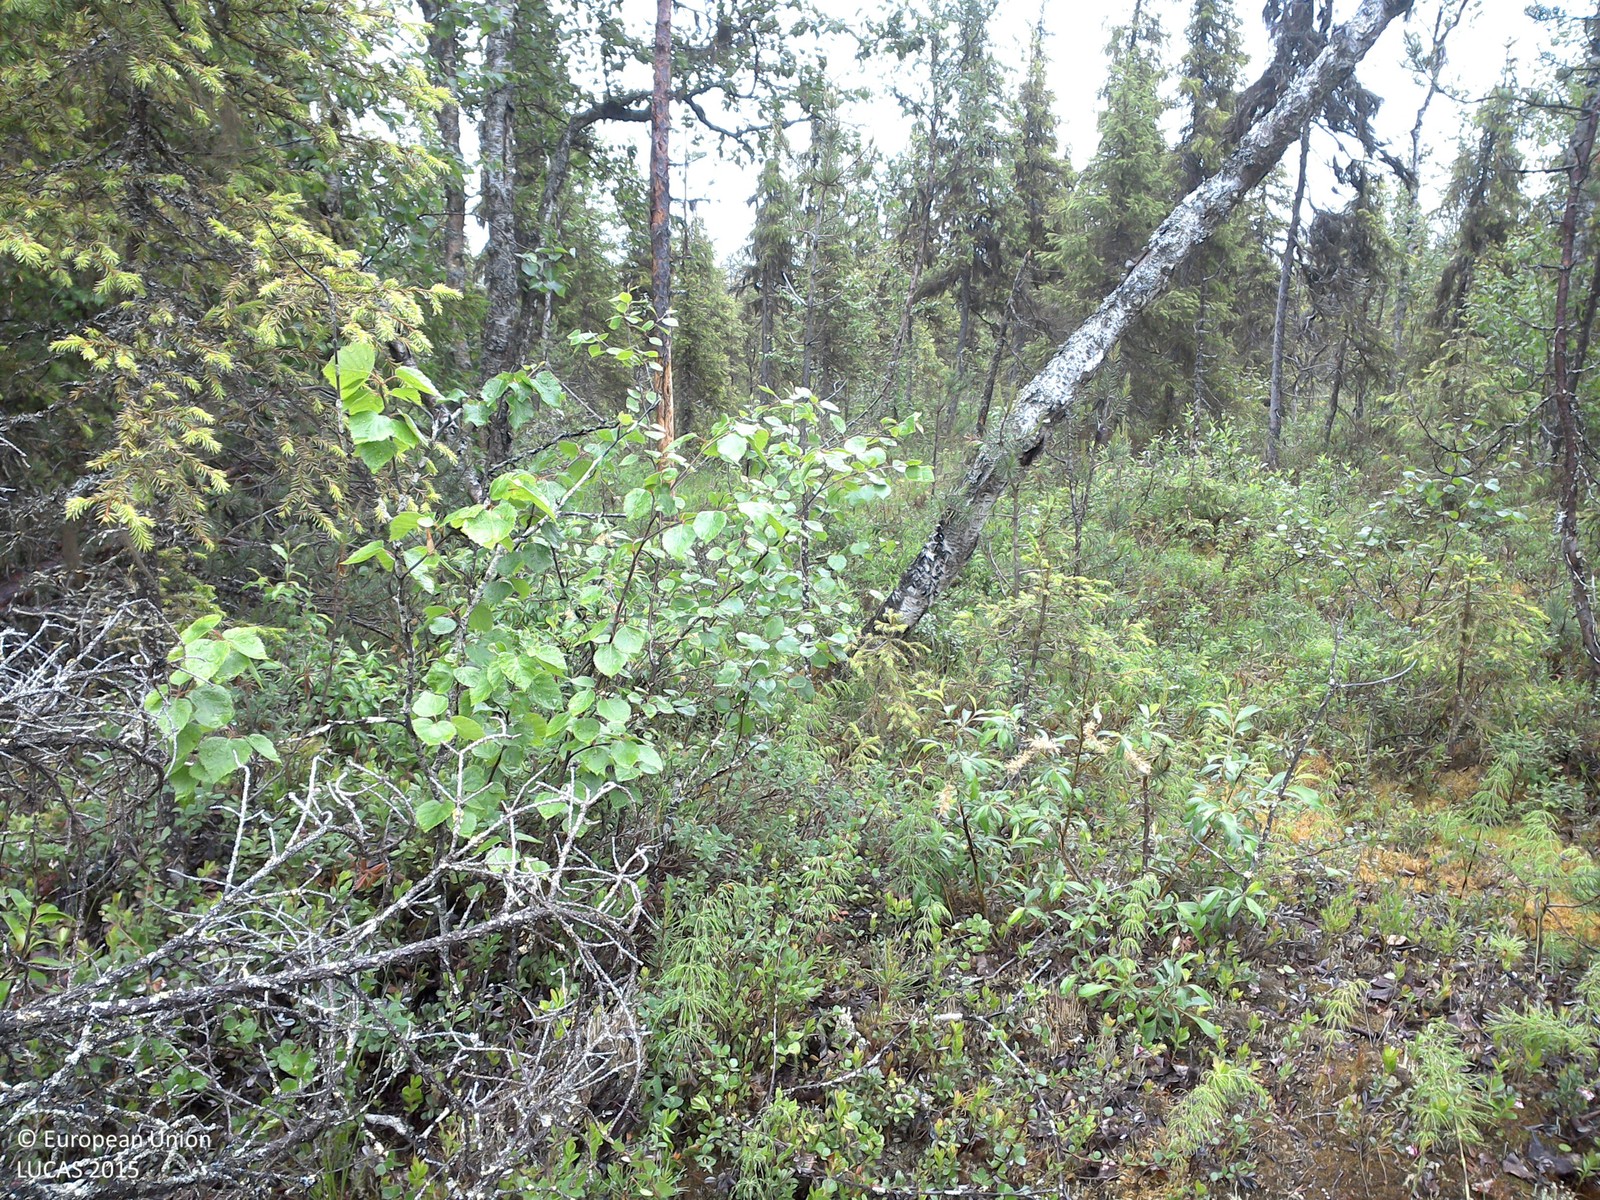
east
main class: Woodland
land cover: Pine dominated mixed woodland
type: boreal forest
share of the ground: 25 - 50 %
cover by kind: shrubs 55 %, coniferous forest trees 20 %, broadleaved forest trees 10 %, herbaceous plants 10 %, lichens and mosses 5 %
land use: Forestry
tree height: > 5 m
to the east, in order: Pine dominated mixed woodland; Spruce dominated mixed woodland; Spruce dominated coniferous woodland; Ditches and canals; Spruce dominated coniferous woodland; Spruce dominated mixed woodland; Ditches and canals; Groves; Pine dominated mixed woodland; Ditches and canals; Broadleaved woodland; Pine dominated coniferous woodland
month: July
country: SE
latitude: 67.1029
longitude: 23.6350
